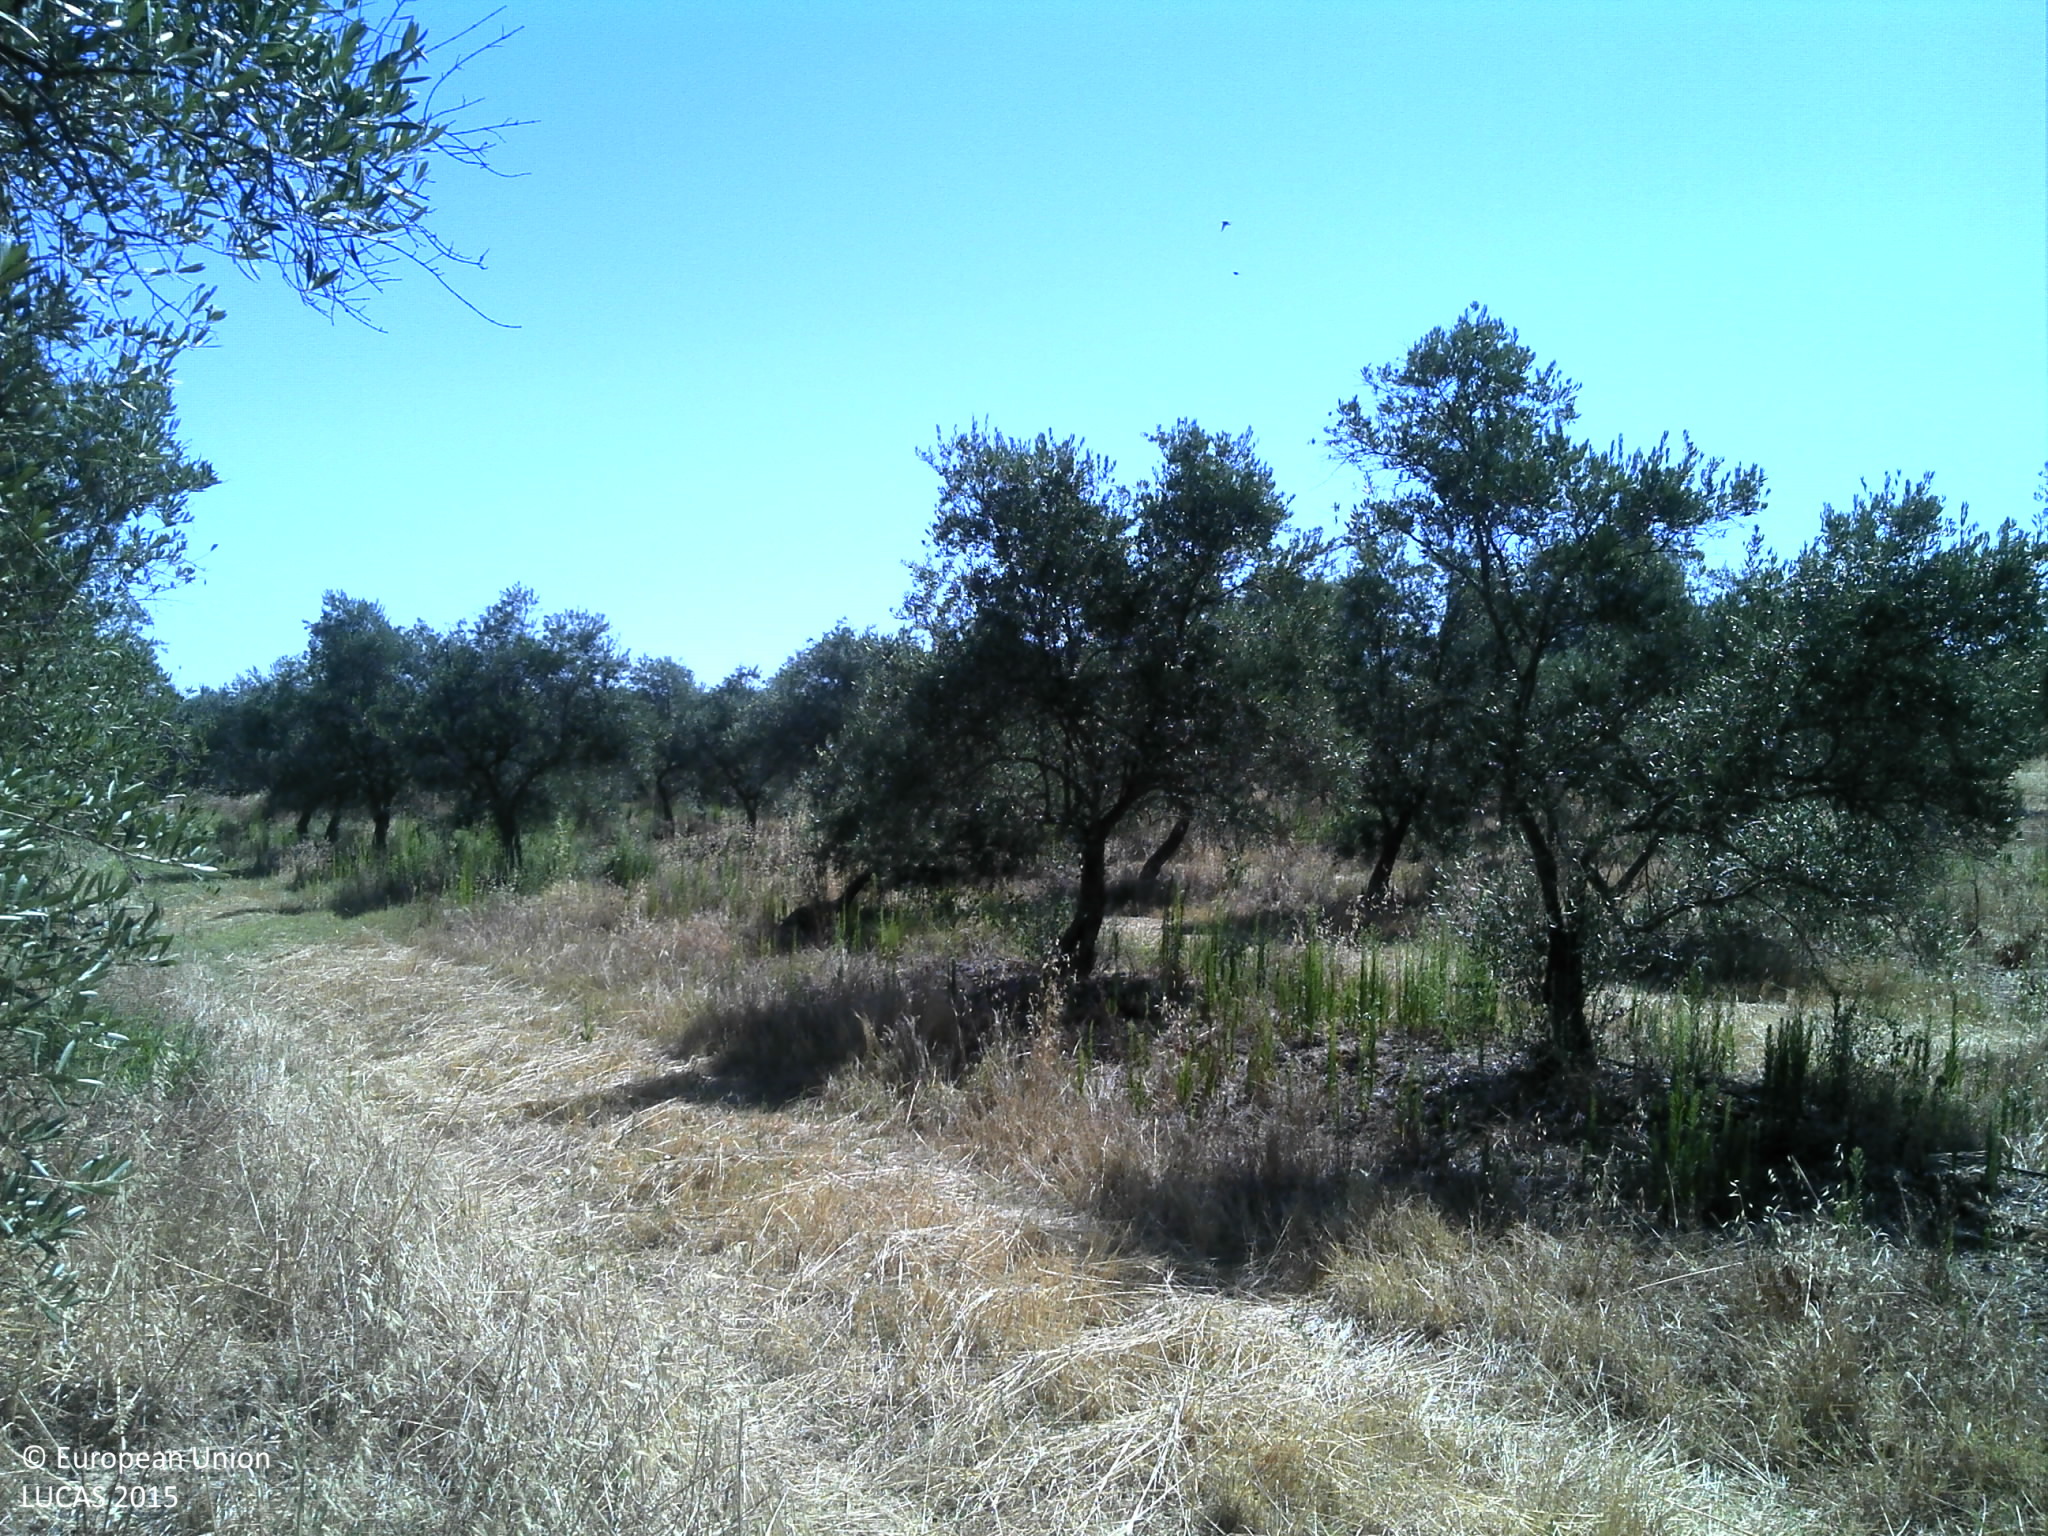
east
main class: Cropland
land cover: Olive groves
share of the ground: 25 - 50 %
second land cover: Grassland without tree/shrub cover
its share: > 75 %
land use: Agriculture (excluding fallow land and kitchen gardens)
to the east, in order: Olive groves; Grassland without tree/shrub cover; Olive groves; Tracks; Olive groves; Electric lines; Grass margins; Fences; Broadleaved woodland; Grass margins; Ditches and canals; Grass margins; Paved roads, cycling and walking lanes; Grass margins; Ditches and canals; Grass margins; Fences; Olive groves
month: July
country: PT
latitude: 38.9312
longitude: -7.4423
